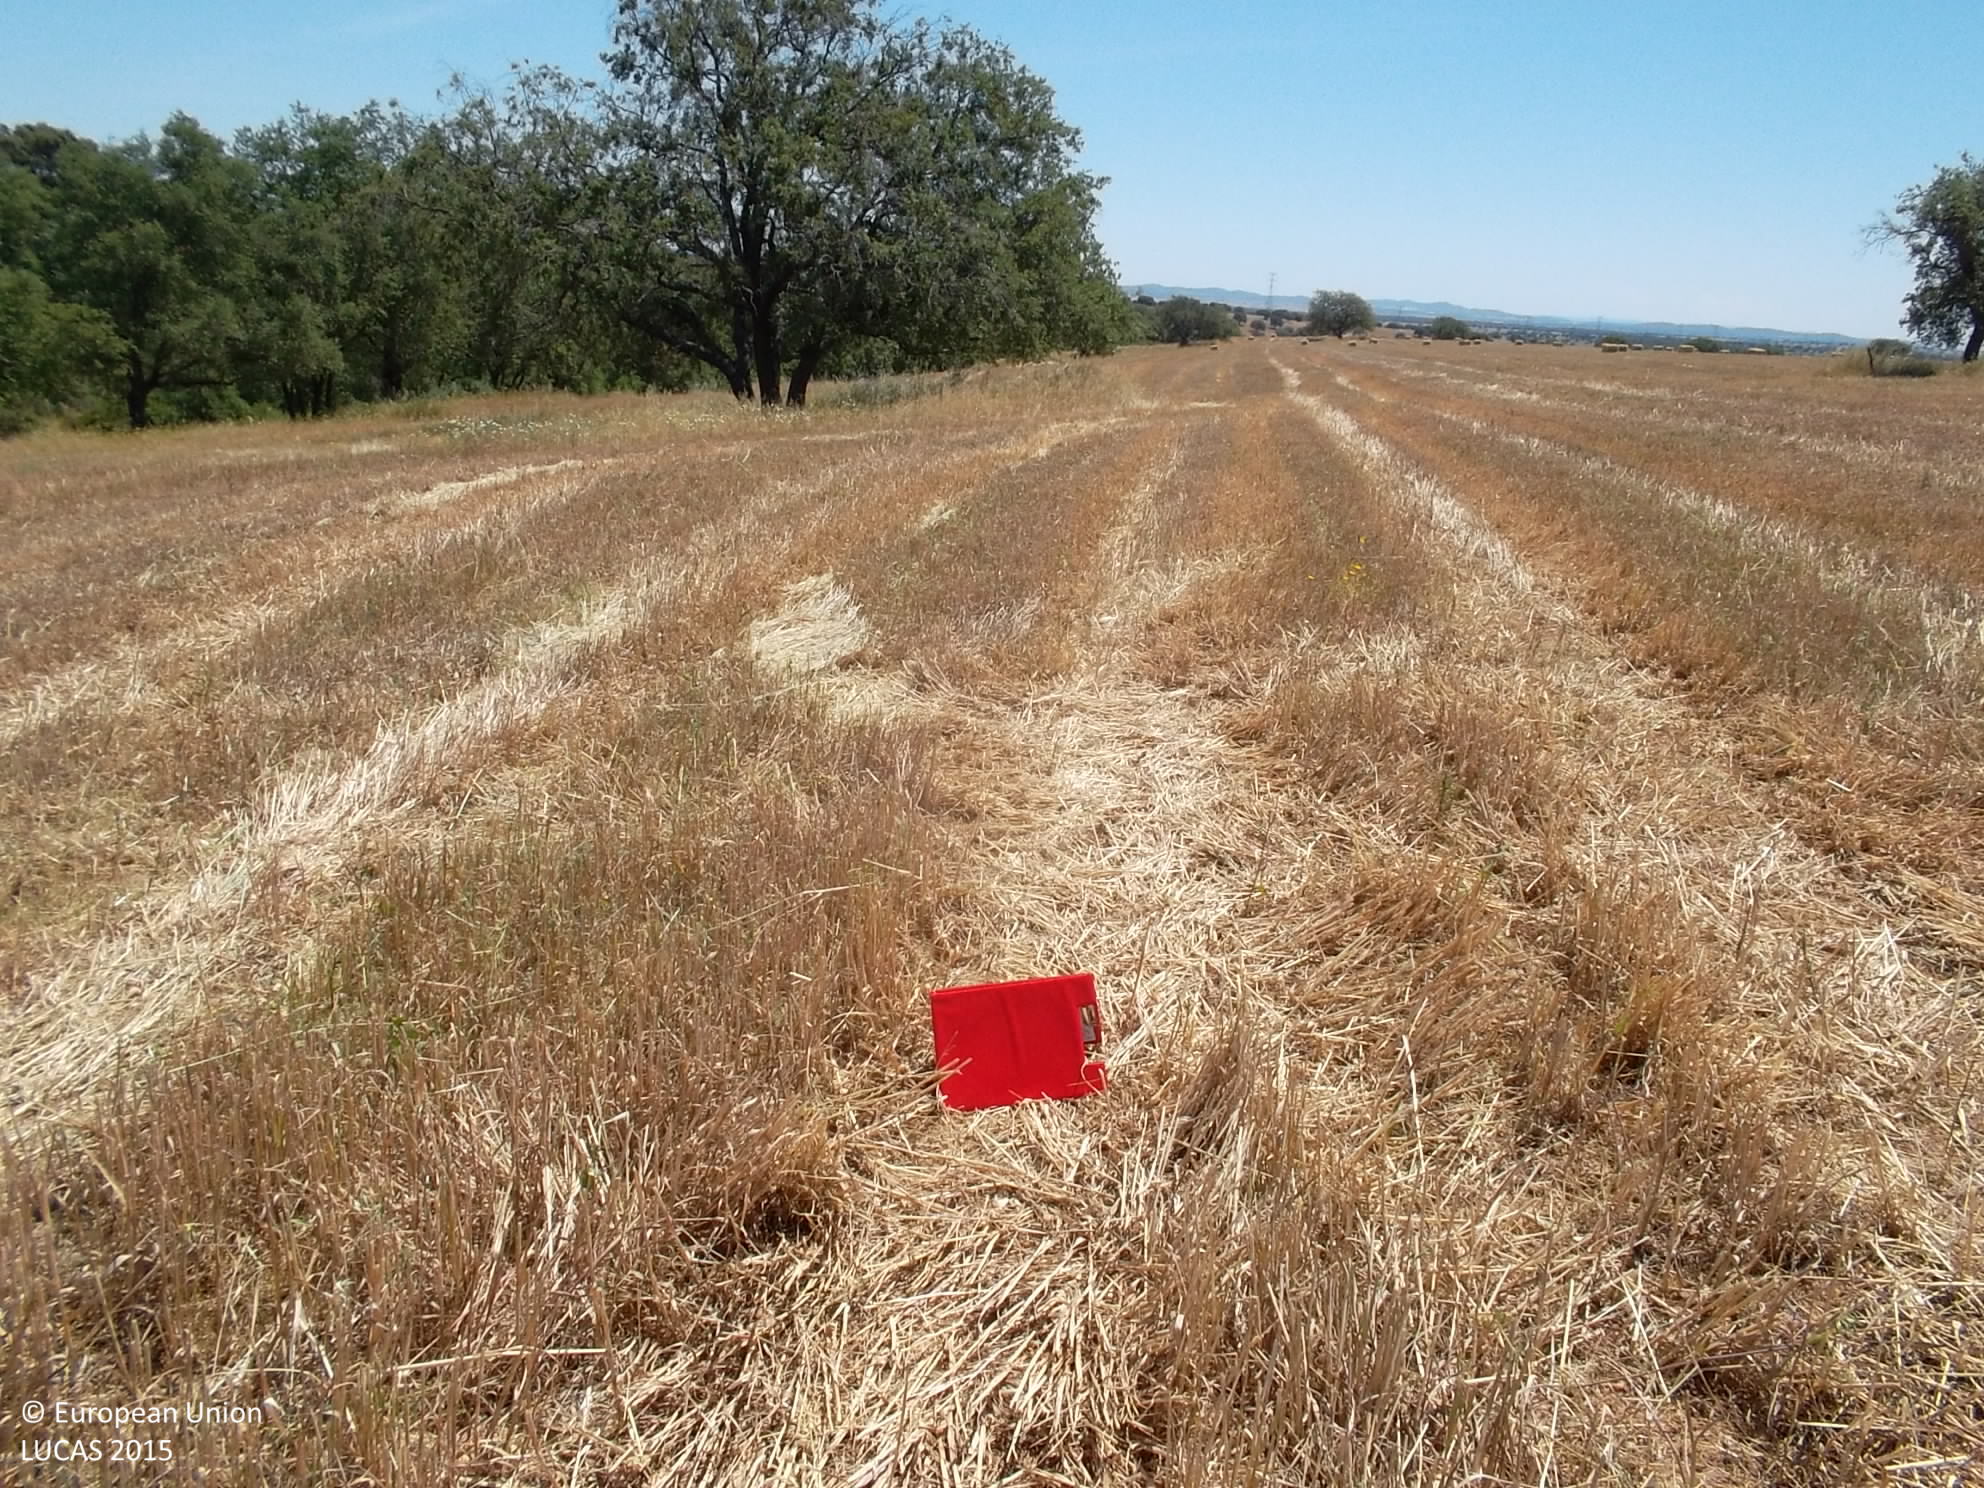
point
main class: Cropland
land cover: Oats
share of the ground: > 75 %
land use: Agriculture (excluding fallow land and kitchen gardens)
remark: Harvested field
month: May
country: ES
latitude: 38.9229
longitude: -4.5259
